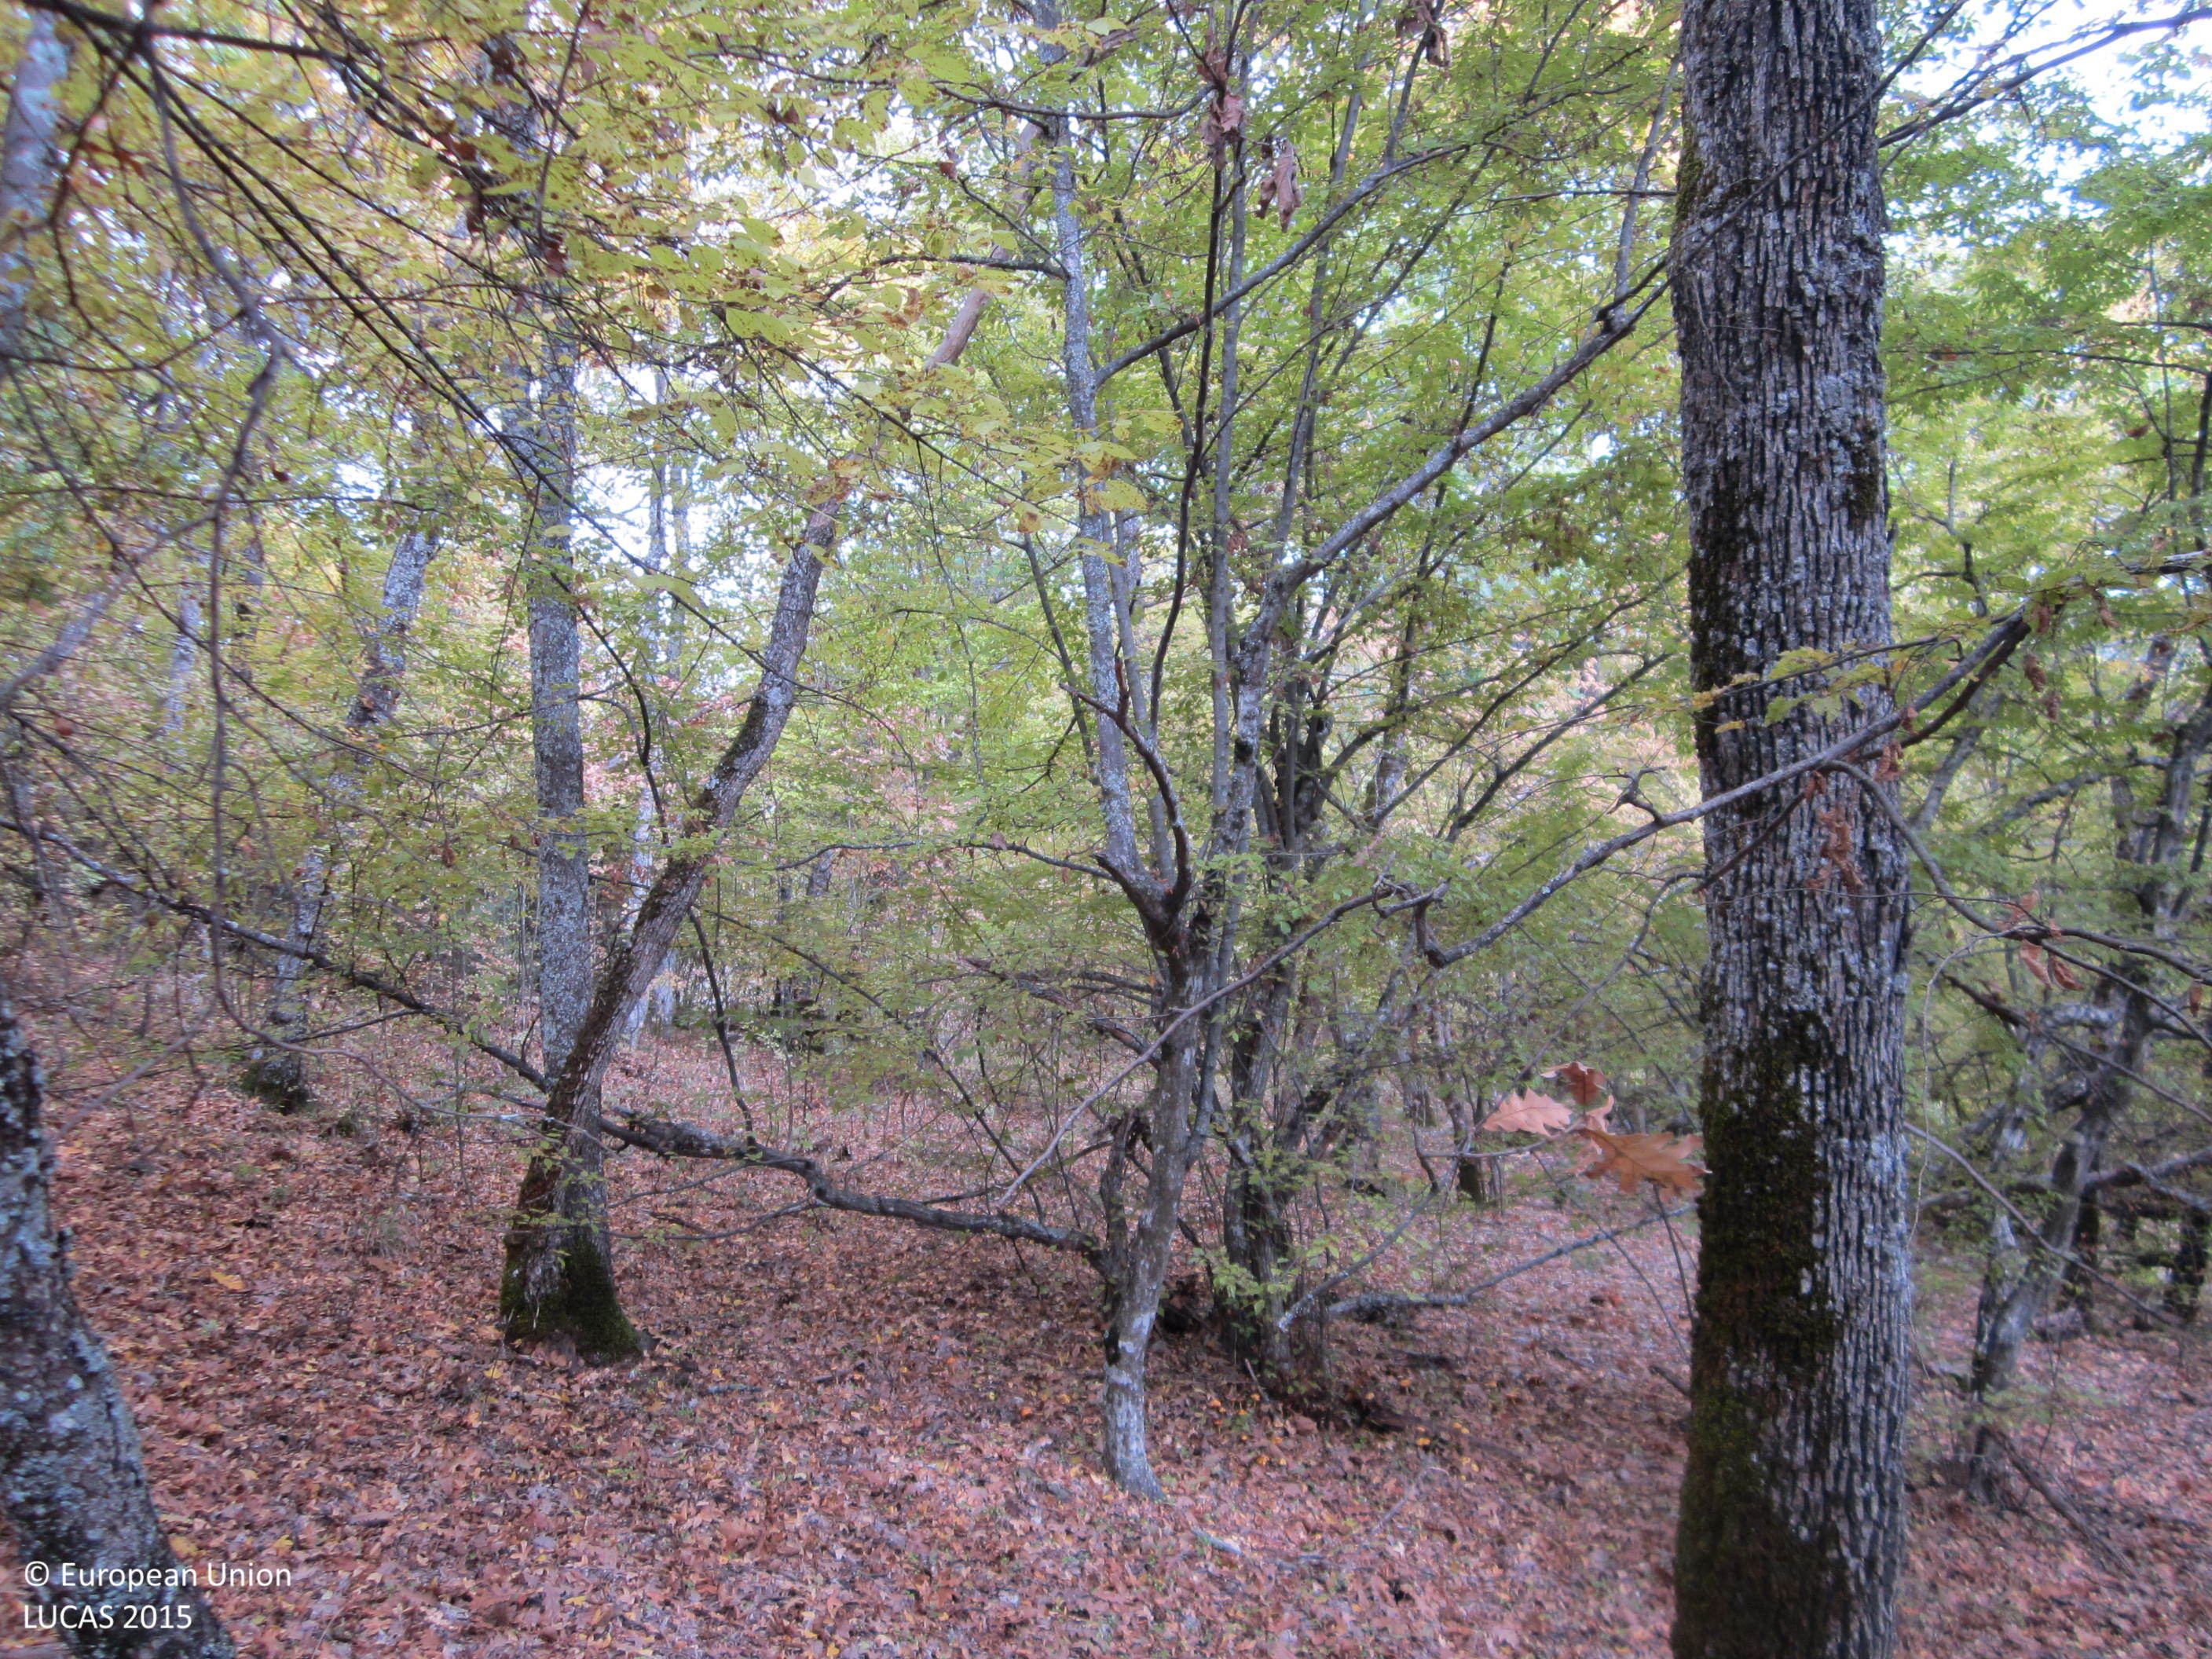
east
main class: Woodland
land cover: Broadleaved woodland
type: mesophytic deciduous forest
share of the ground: > 75 %
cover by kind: broadleaved forest trees 80 %, unconsolidated bare surface 10 %, shrubs 5 %, lichens and mosses 5 %
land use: Forestry
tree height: > 5 m
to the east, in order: Broadleaved woodland; Grassland with sparse tree/shrub cover; Broadleaved woodland
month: November
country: BG
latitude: 41.4400
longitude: 25.9235
